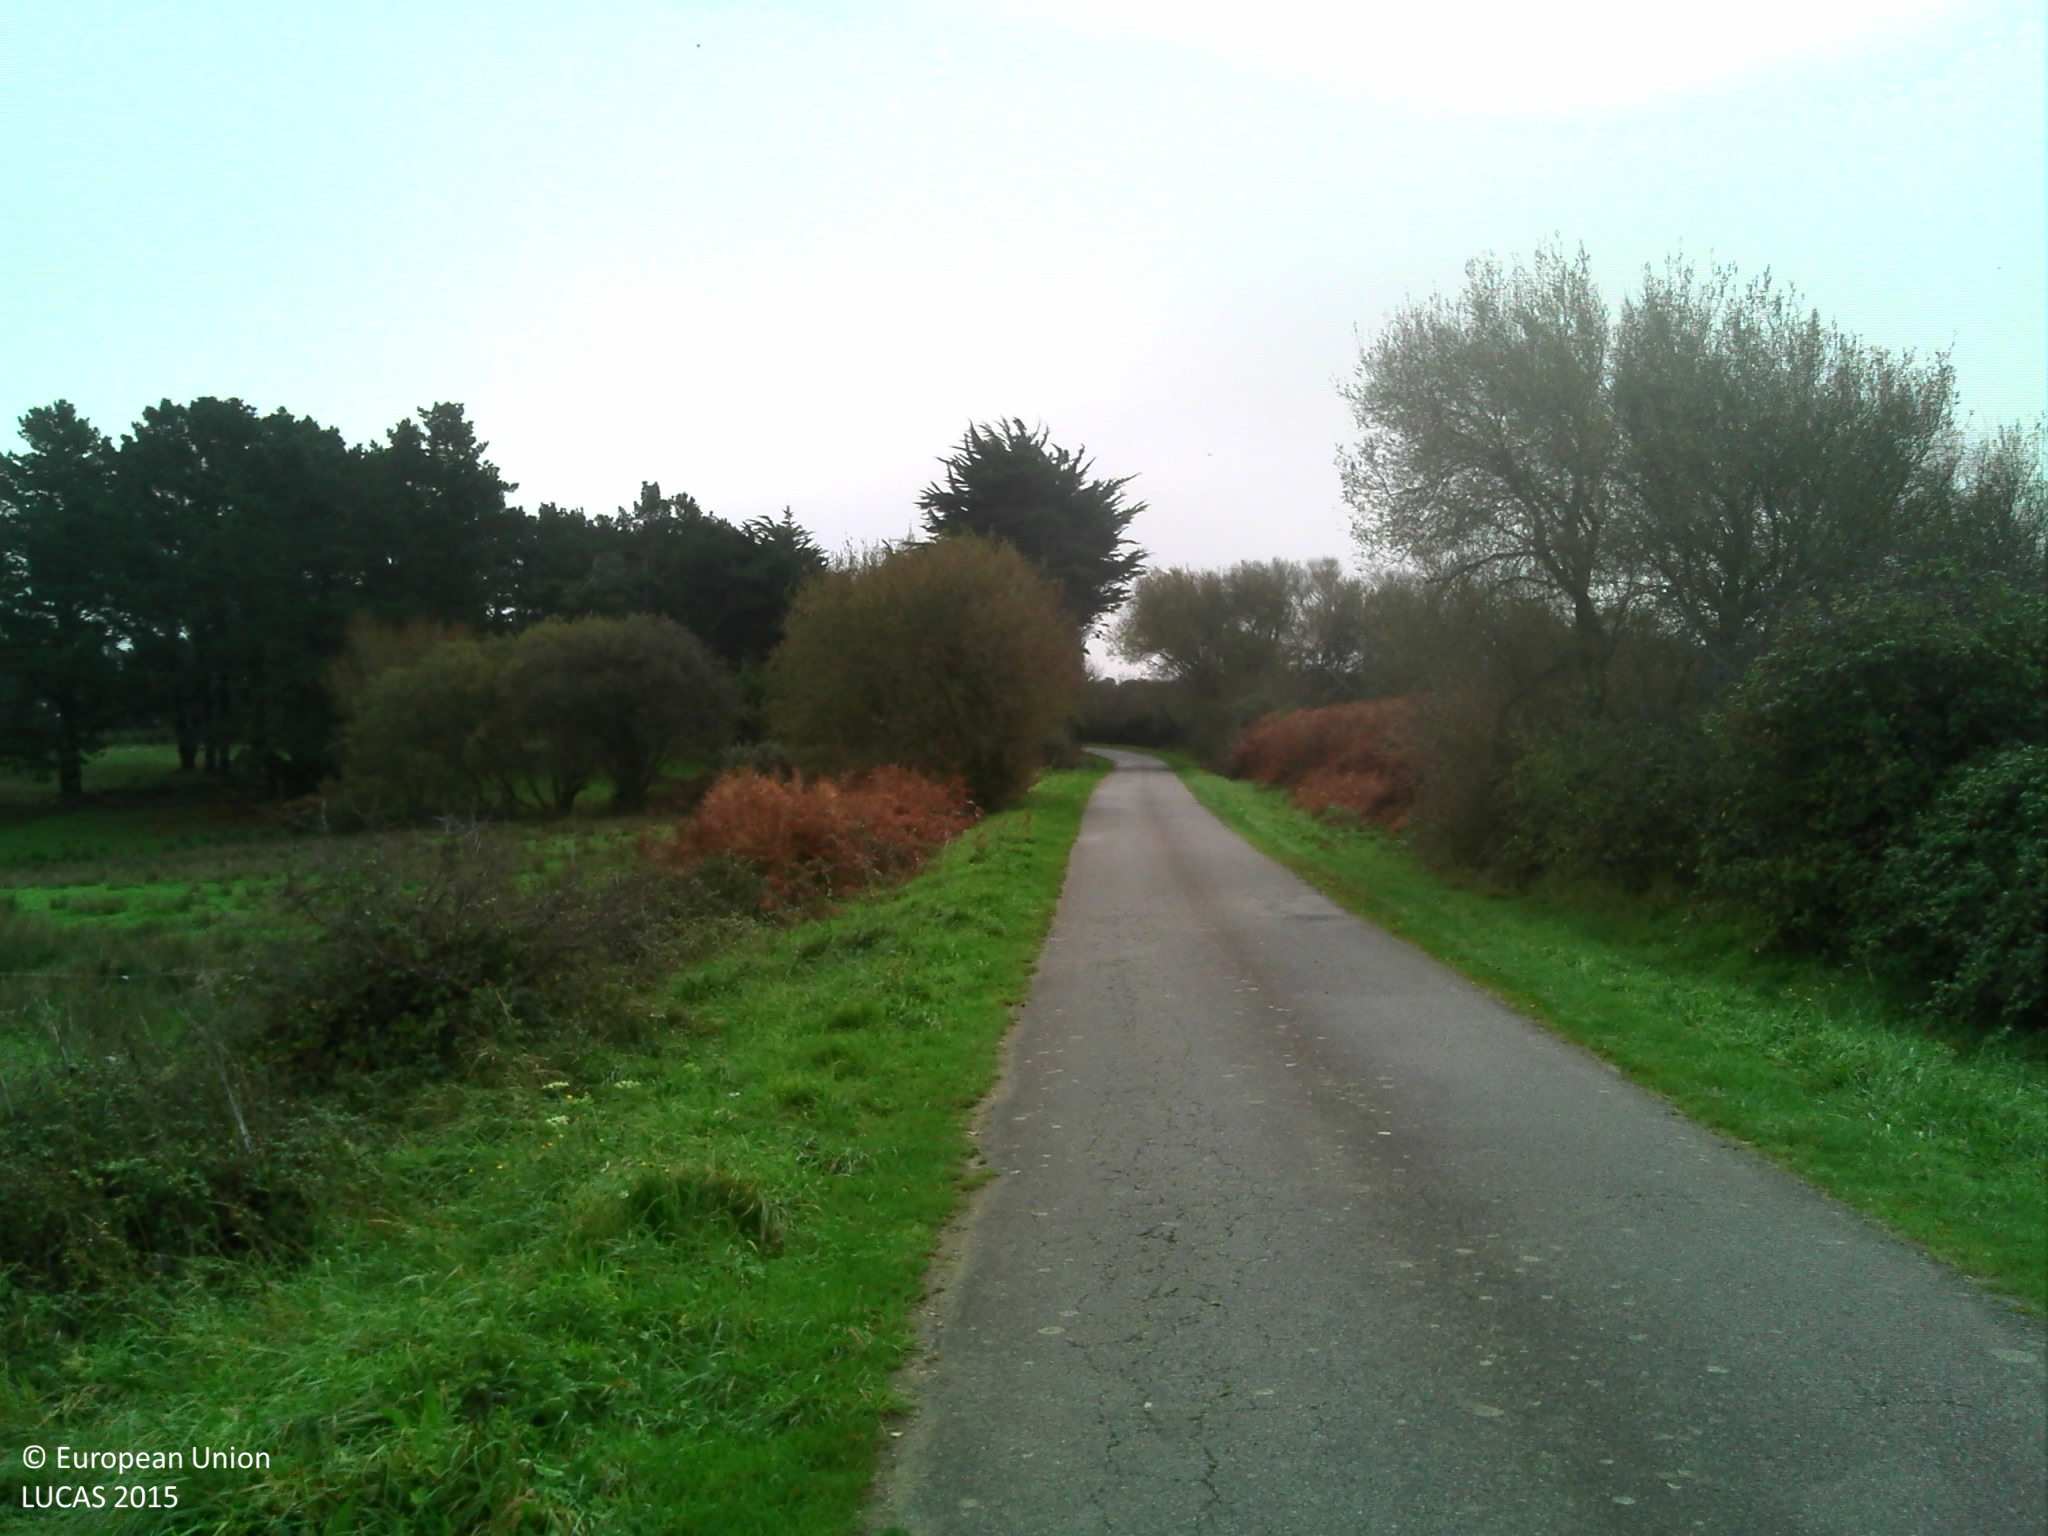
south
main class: Shrubland
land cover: Shrubland with sparse tree cover
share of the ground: > 75 %
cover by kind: shrubs 95 %, broadleaved forest trees 5 %
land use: Semi-natural and natural areas not in use
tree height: < 5 m
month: November
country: FR
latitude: 47.3075
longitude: -3.1211
